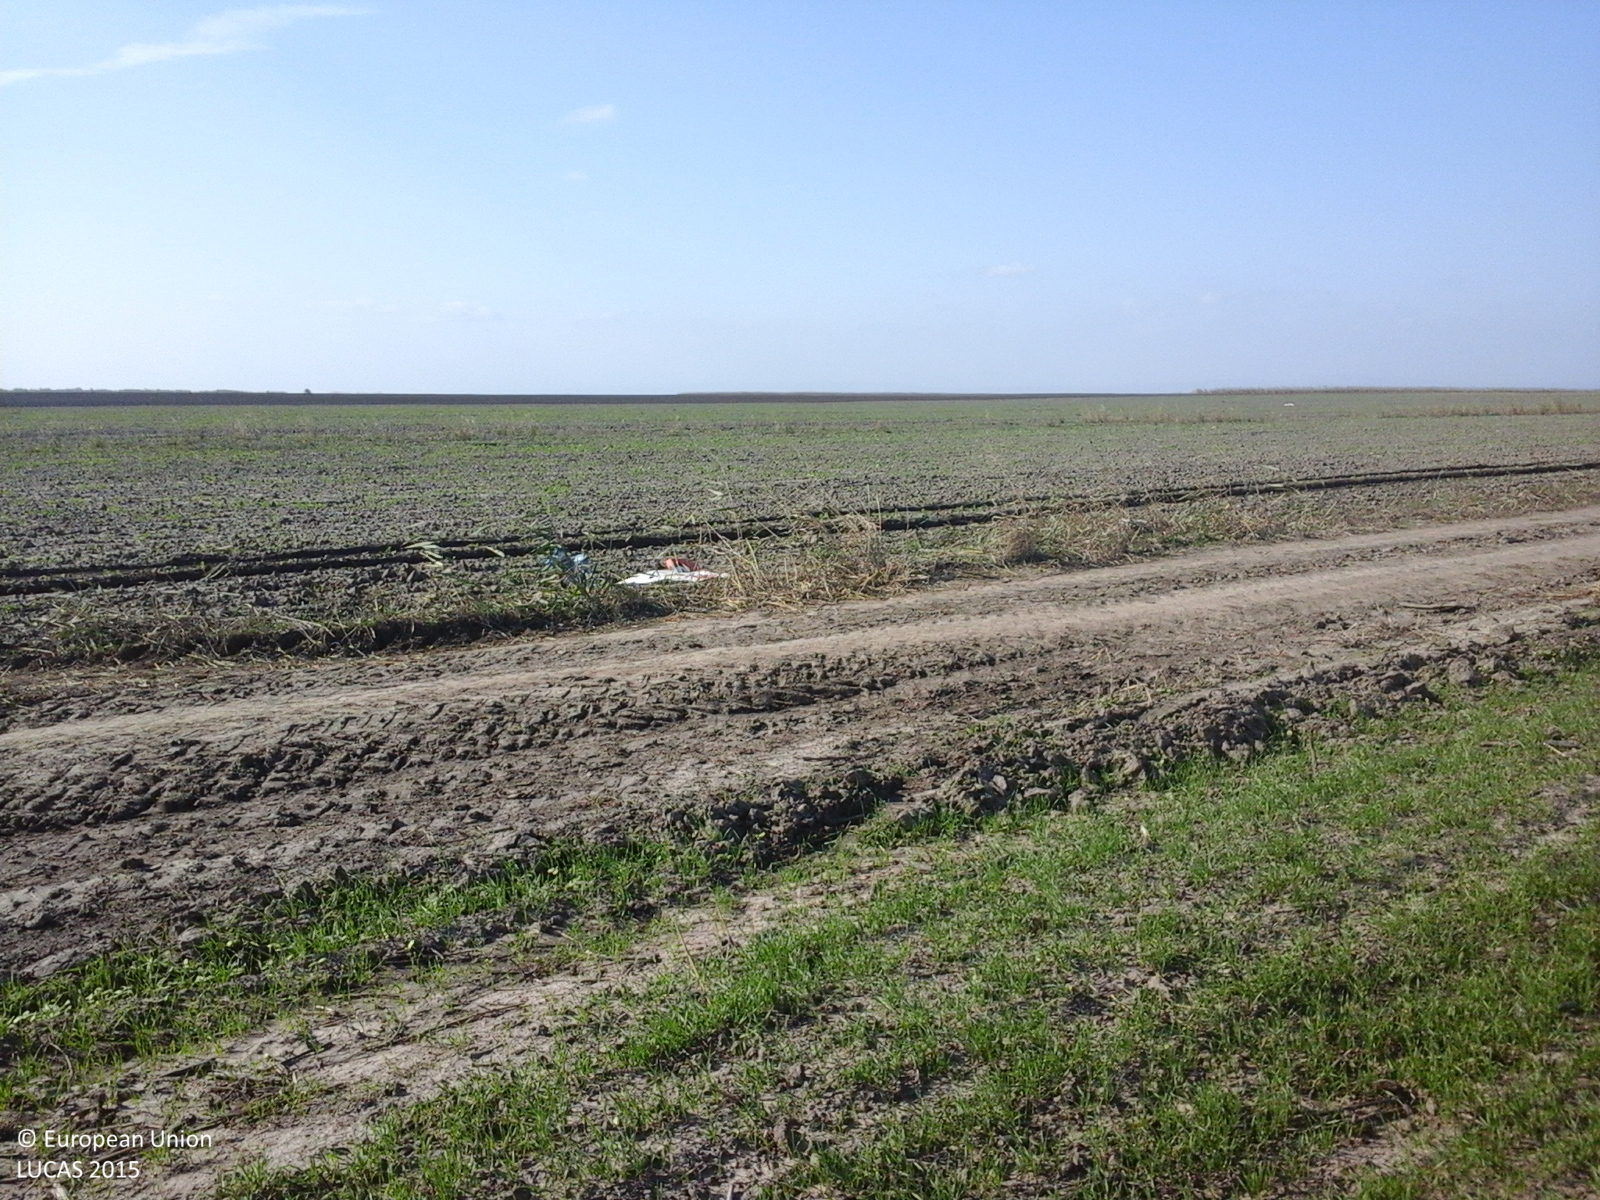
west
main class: Cropland
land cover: Common wheat
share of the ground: 10 - 25 %
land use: Agriculture (excluding fallow land and kitchen gardens)
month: October
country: RO
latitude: 45.4627
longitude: 27.4029
